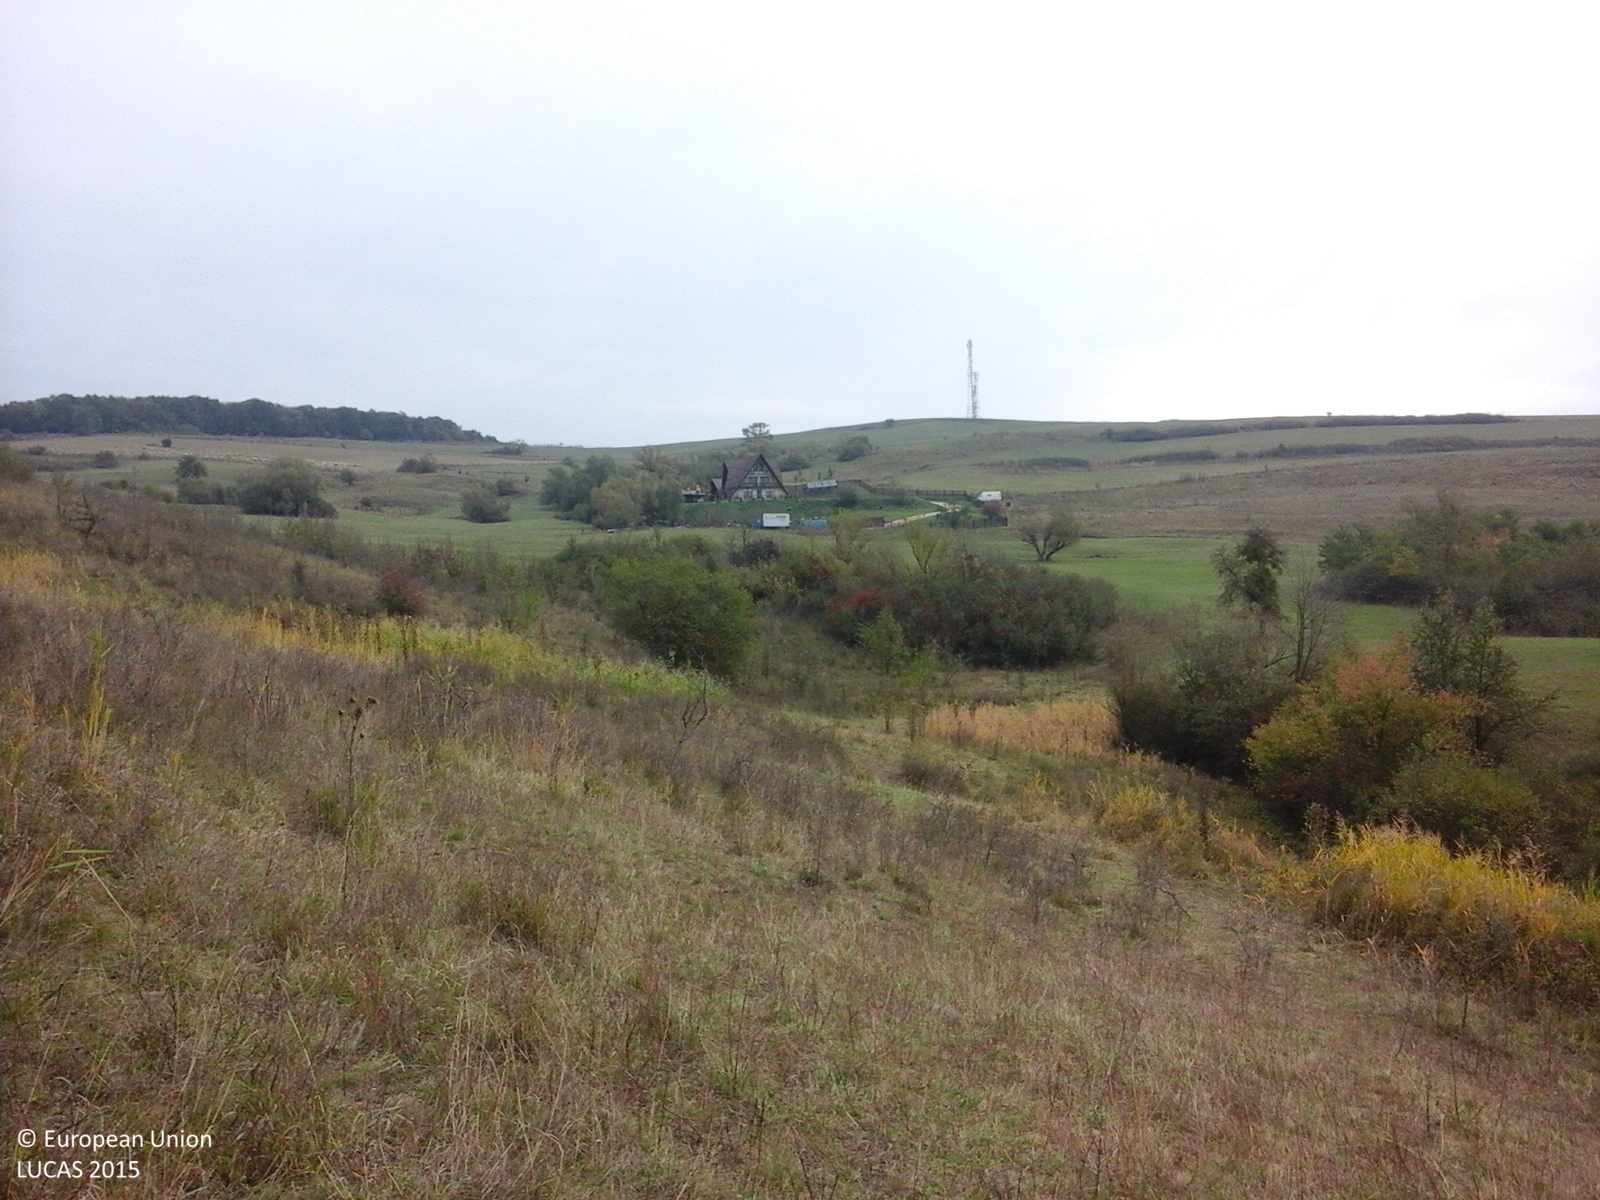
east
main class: Grassland
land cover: Spontaneously vegetated surfaces
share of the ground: > 75 %
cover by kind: herbaceous plants 100 %
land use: Fallow land
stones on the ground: < 10 %
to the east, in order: Spontaneously vegetated surfaces; Shrubland with sparse tree cover; Grassland without tree/shrub cover; Single bushes/trees; Grassland without tree/shrub cover; Tracks; Grassland without tree/shrub cover
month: October
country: RO
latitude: 46.0438
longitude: 25.2051
